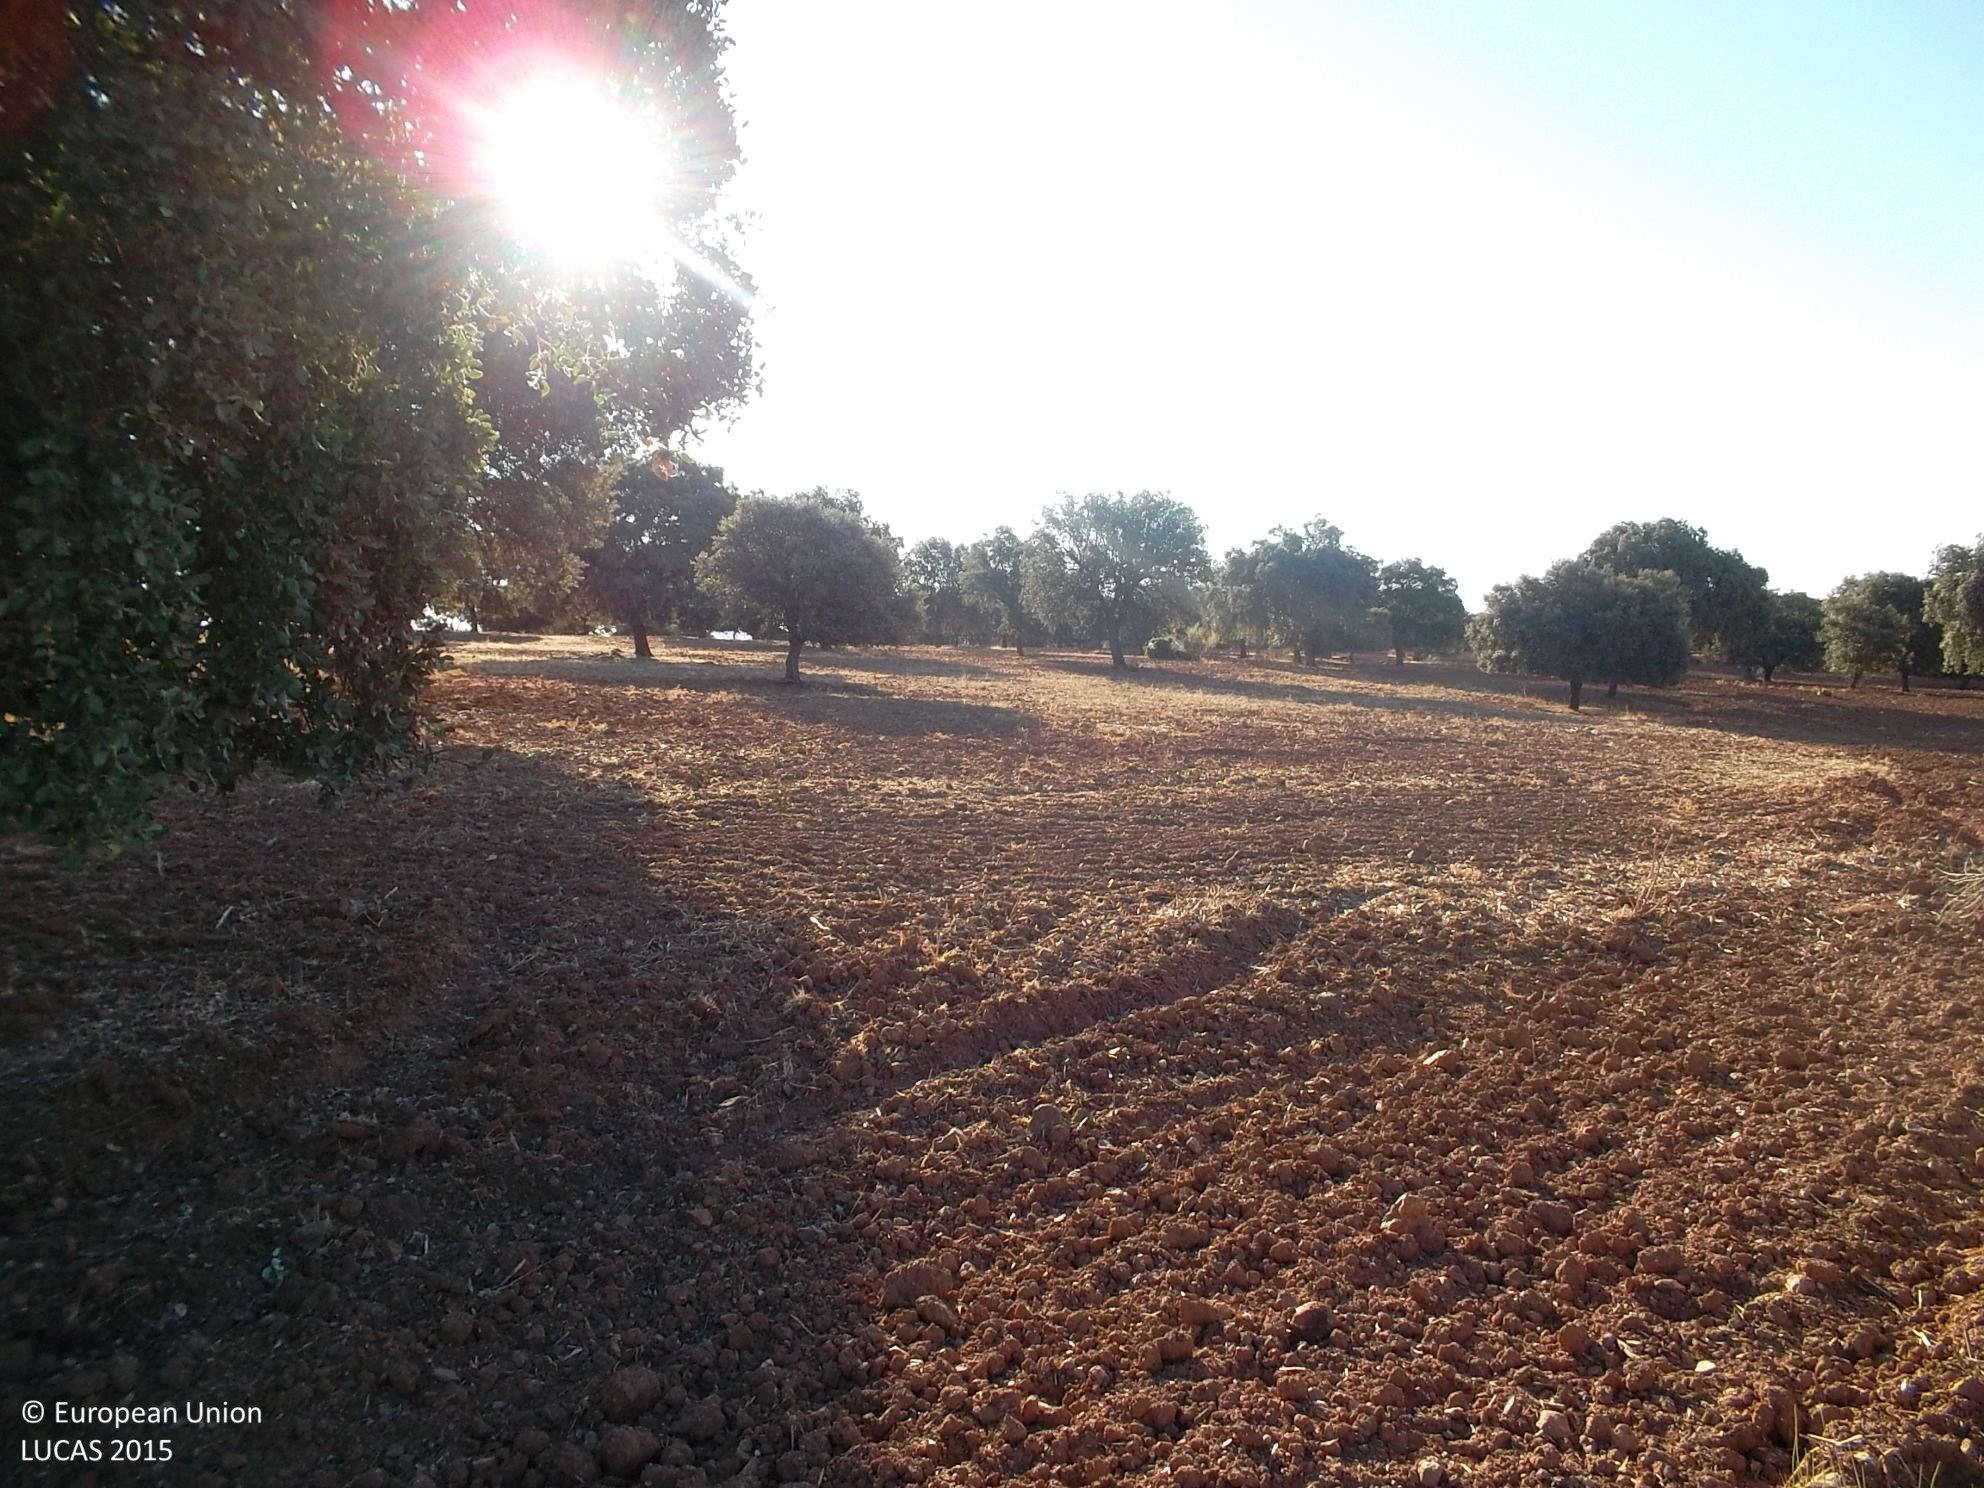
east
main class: Woodland
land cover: Broadleaved woodland
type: broadleaved evergreen forest
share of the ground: 10 - 25 %
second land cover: Spontaneously vegetated surfaces
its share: 10 - 25 %
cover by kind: unconsolidated bare surface 85 %, broadleaved forest trees 15 %
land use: Forestry
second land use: Fallow land
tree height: > 5 m
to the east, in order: Broadleaved woodland; Spontaneously vegetated surfaces
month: July
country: ES
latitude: 38.5058
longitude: -5.7616
